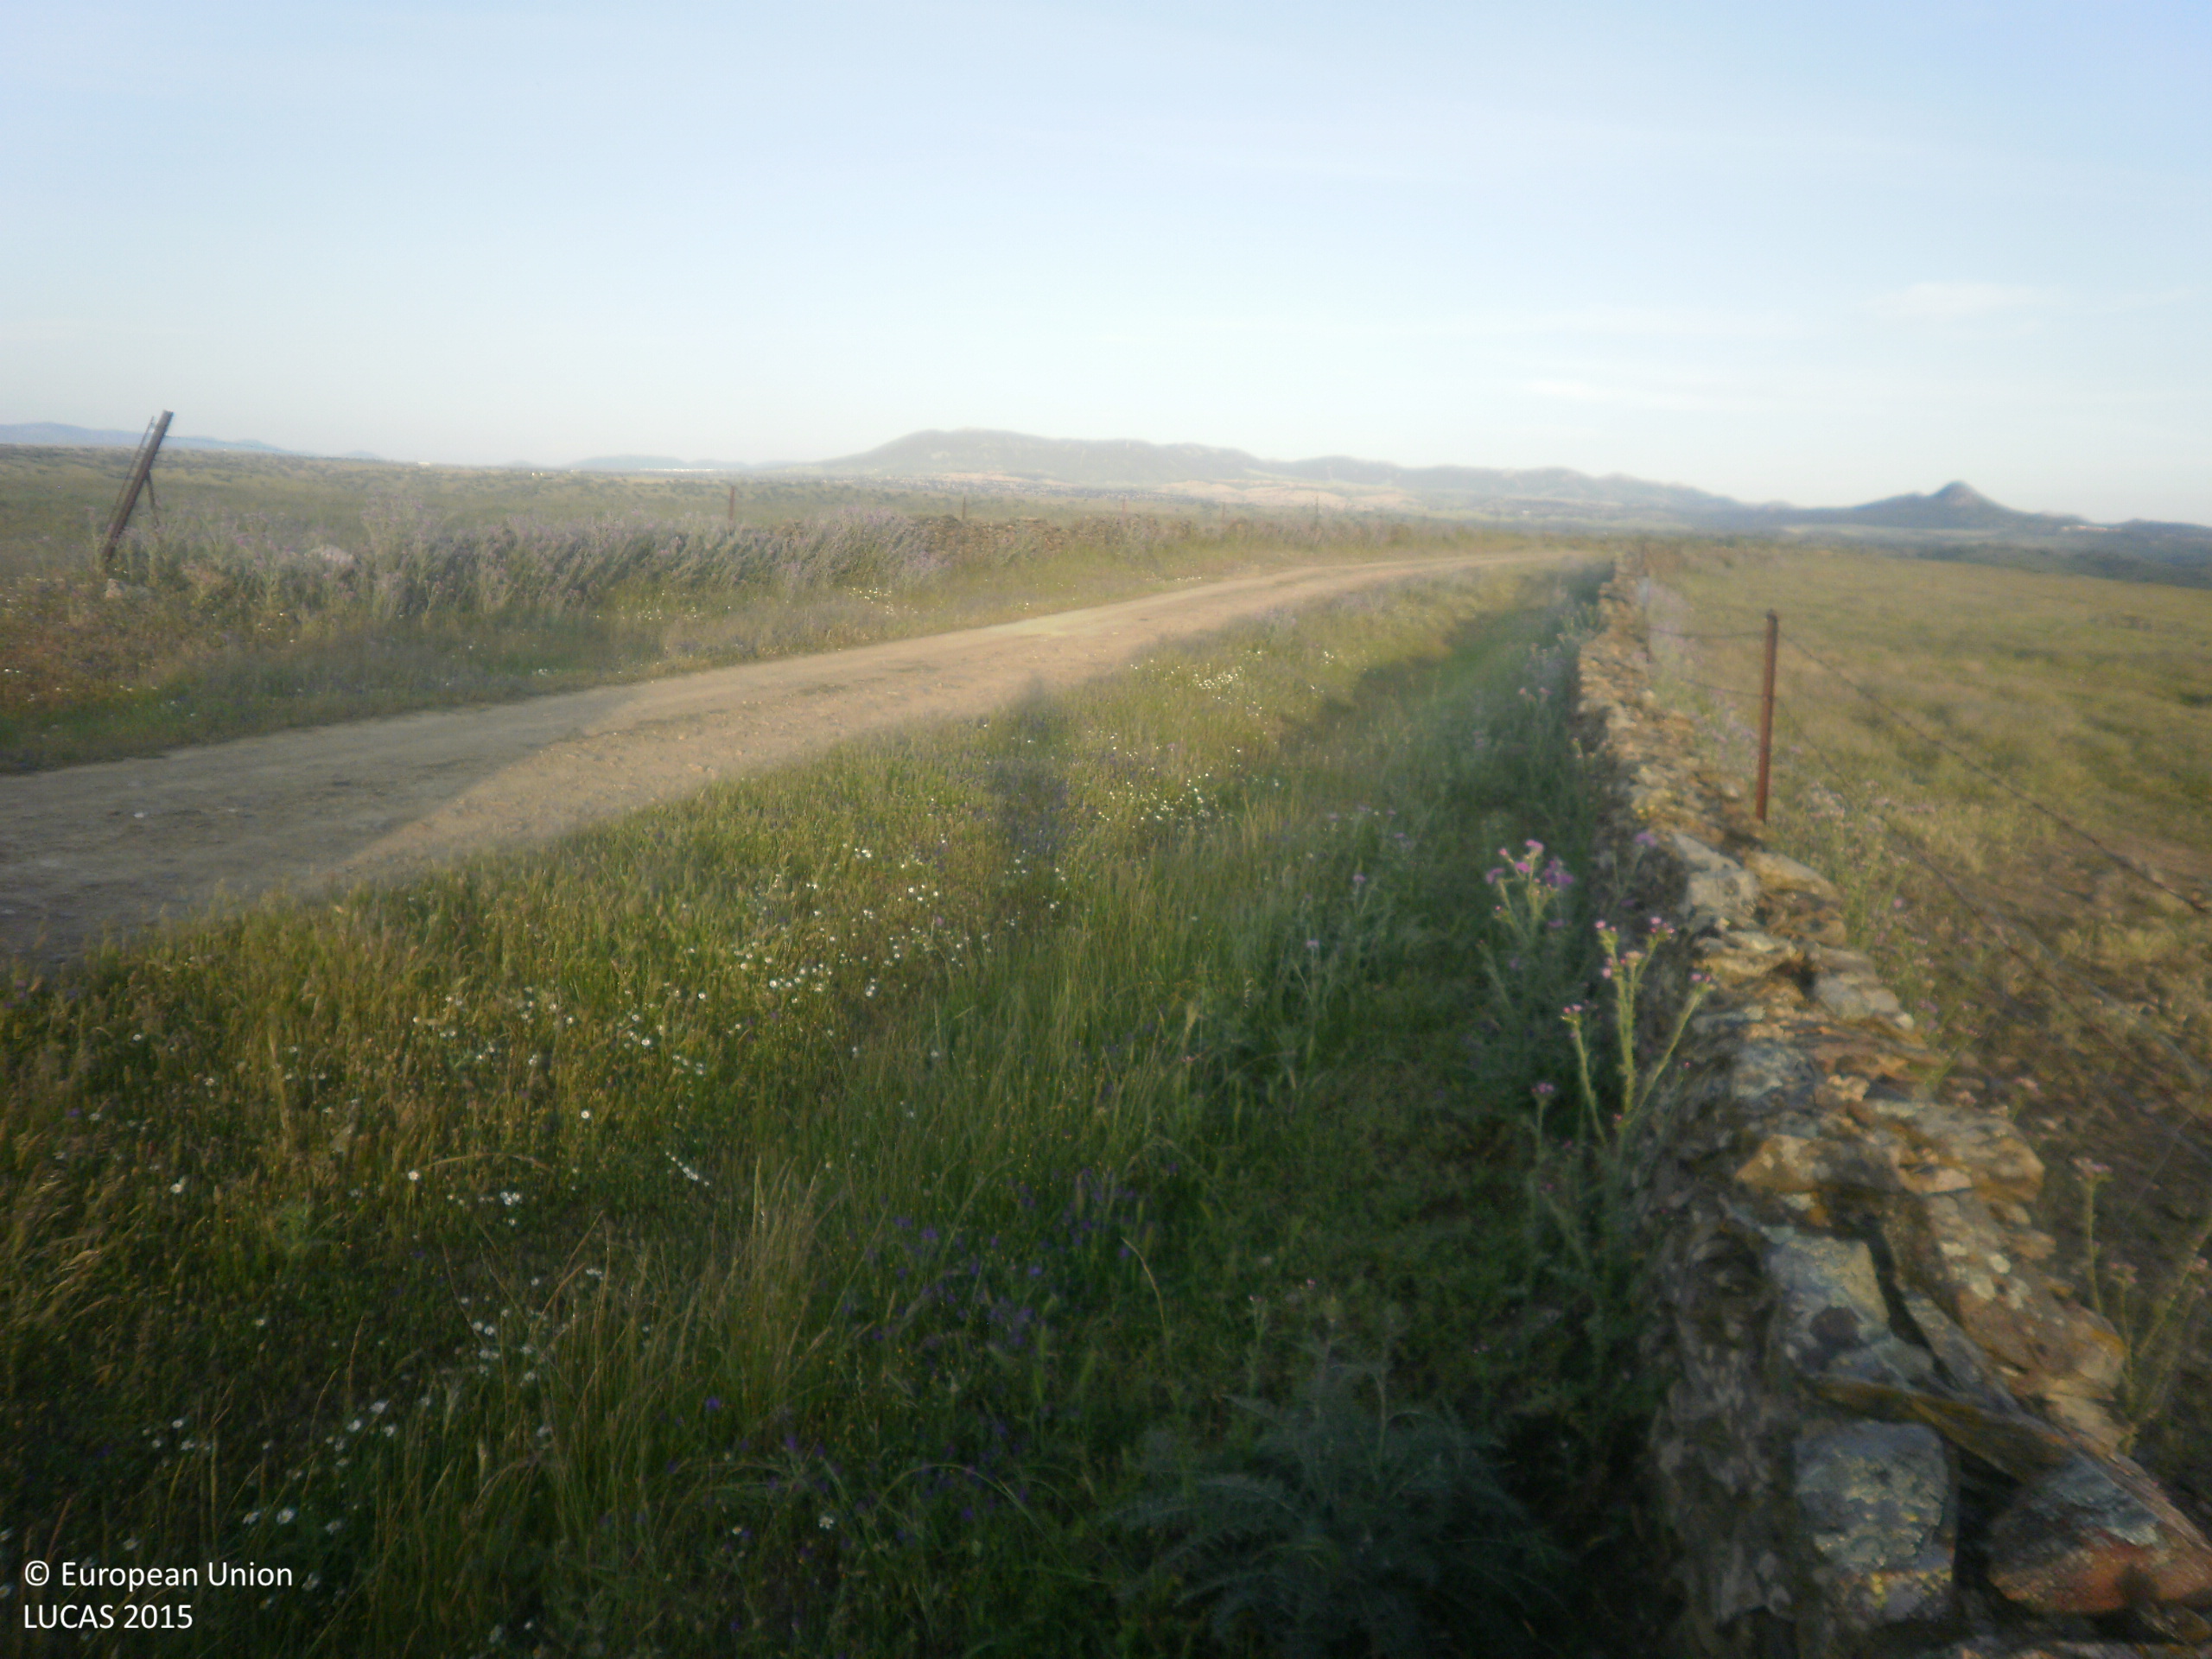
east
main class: Grassland
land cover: Grassland without tree/shrub cover
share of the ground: > 75 %
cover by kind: herbaceous plants 100 %
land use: Agriculture (excluding fallow land and kitchen gardens)
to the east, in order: Grassland without tree/shrub cover; Rock outcrops; Grassland without tree/shrub cover; Rivers and streams; Rock outcrops; Grassland without tree/shrub cover; Dry stone walls; Grassland without tree/shrub cover
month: April
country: ES
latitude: 38.9804
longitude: -5.2185
